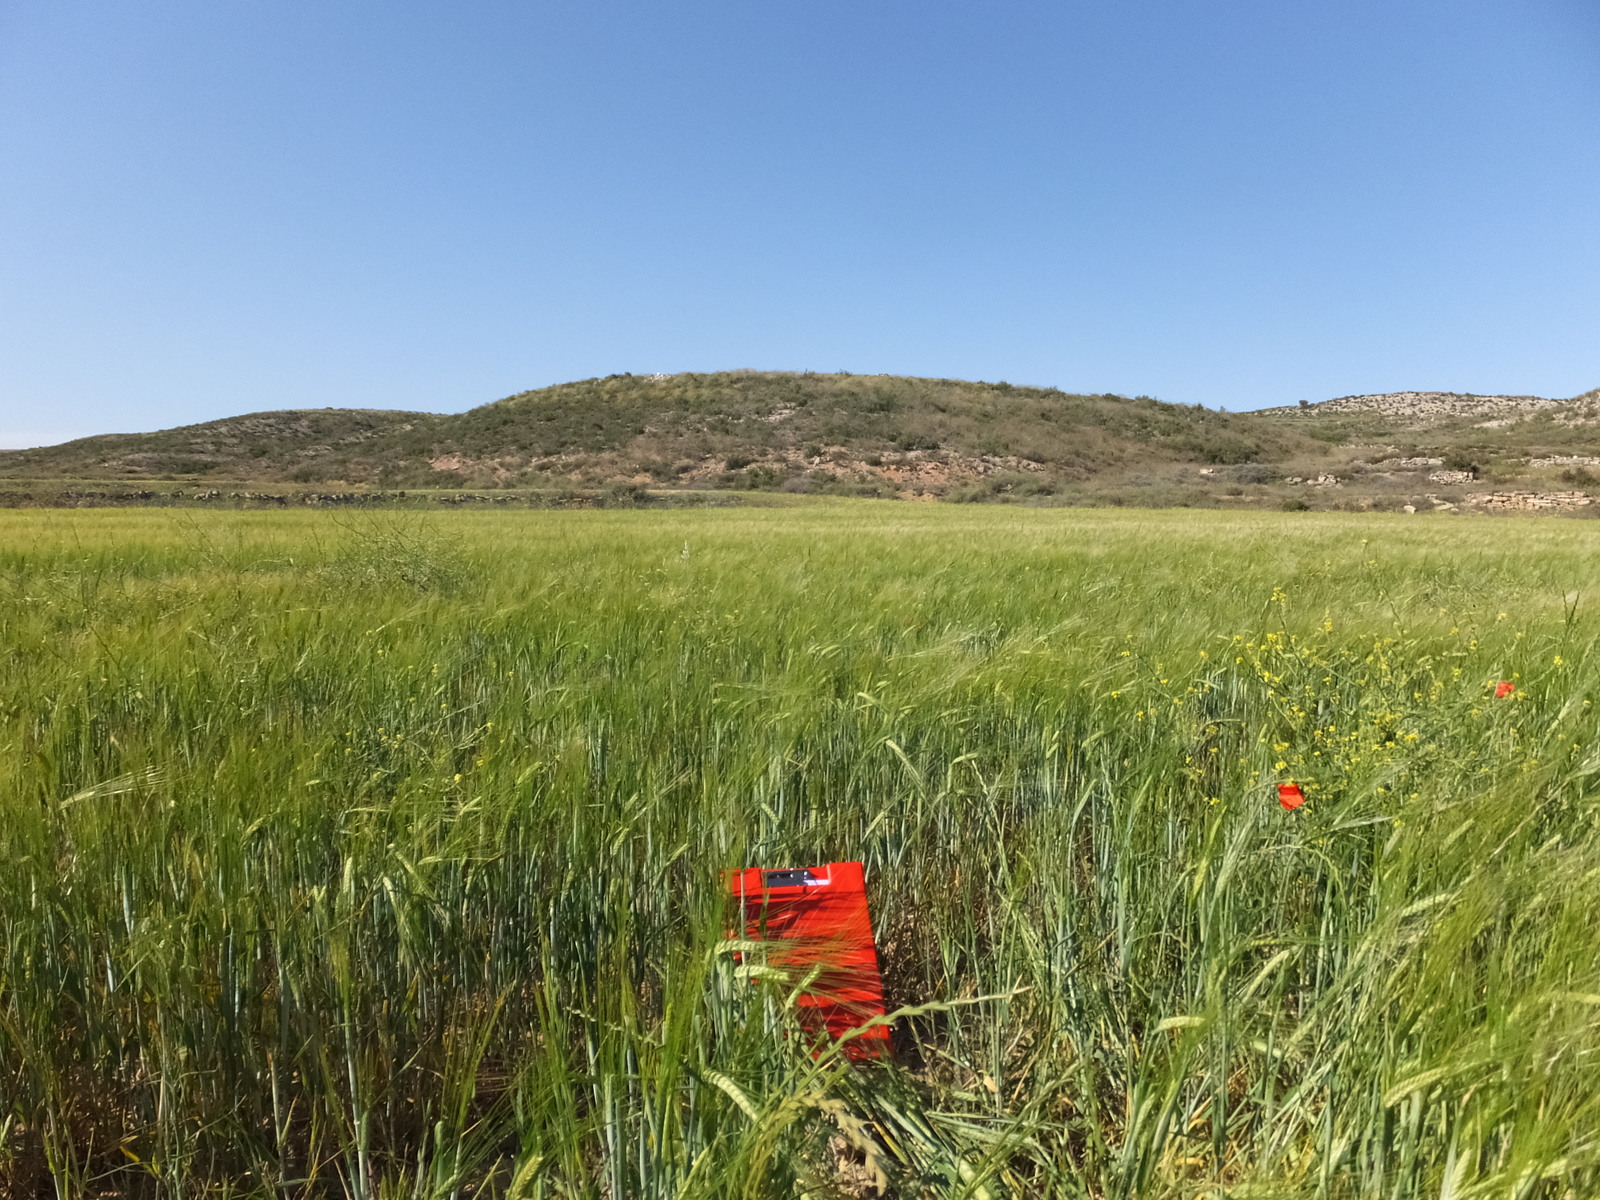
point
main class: Cropland
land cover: Barley
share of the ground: > 75 %
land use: Agriculture (excluding fallow land and kitchen gardens)
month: May
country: ES
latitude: 41.3624
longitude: -0.3078
